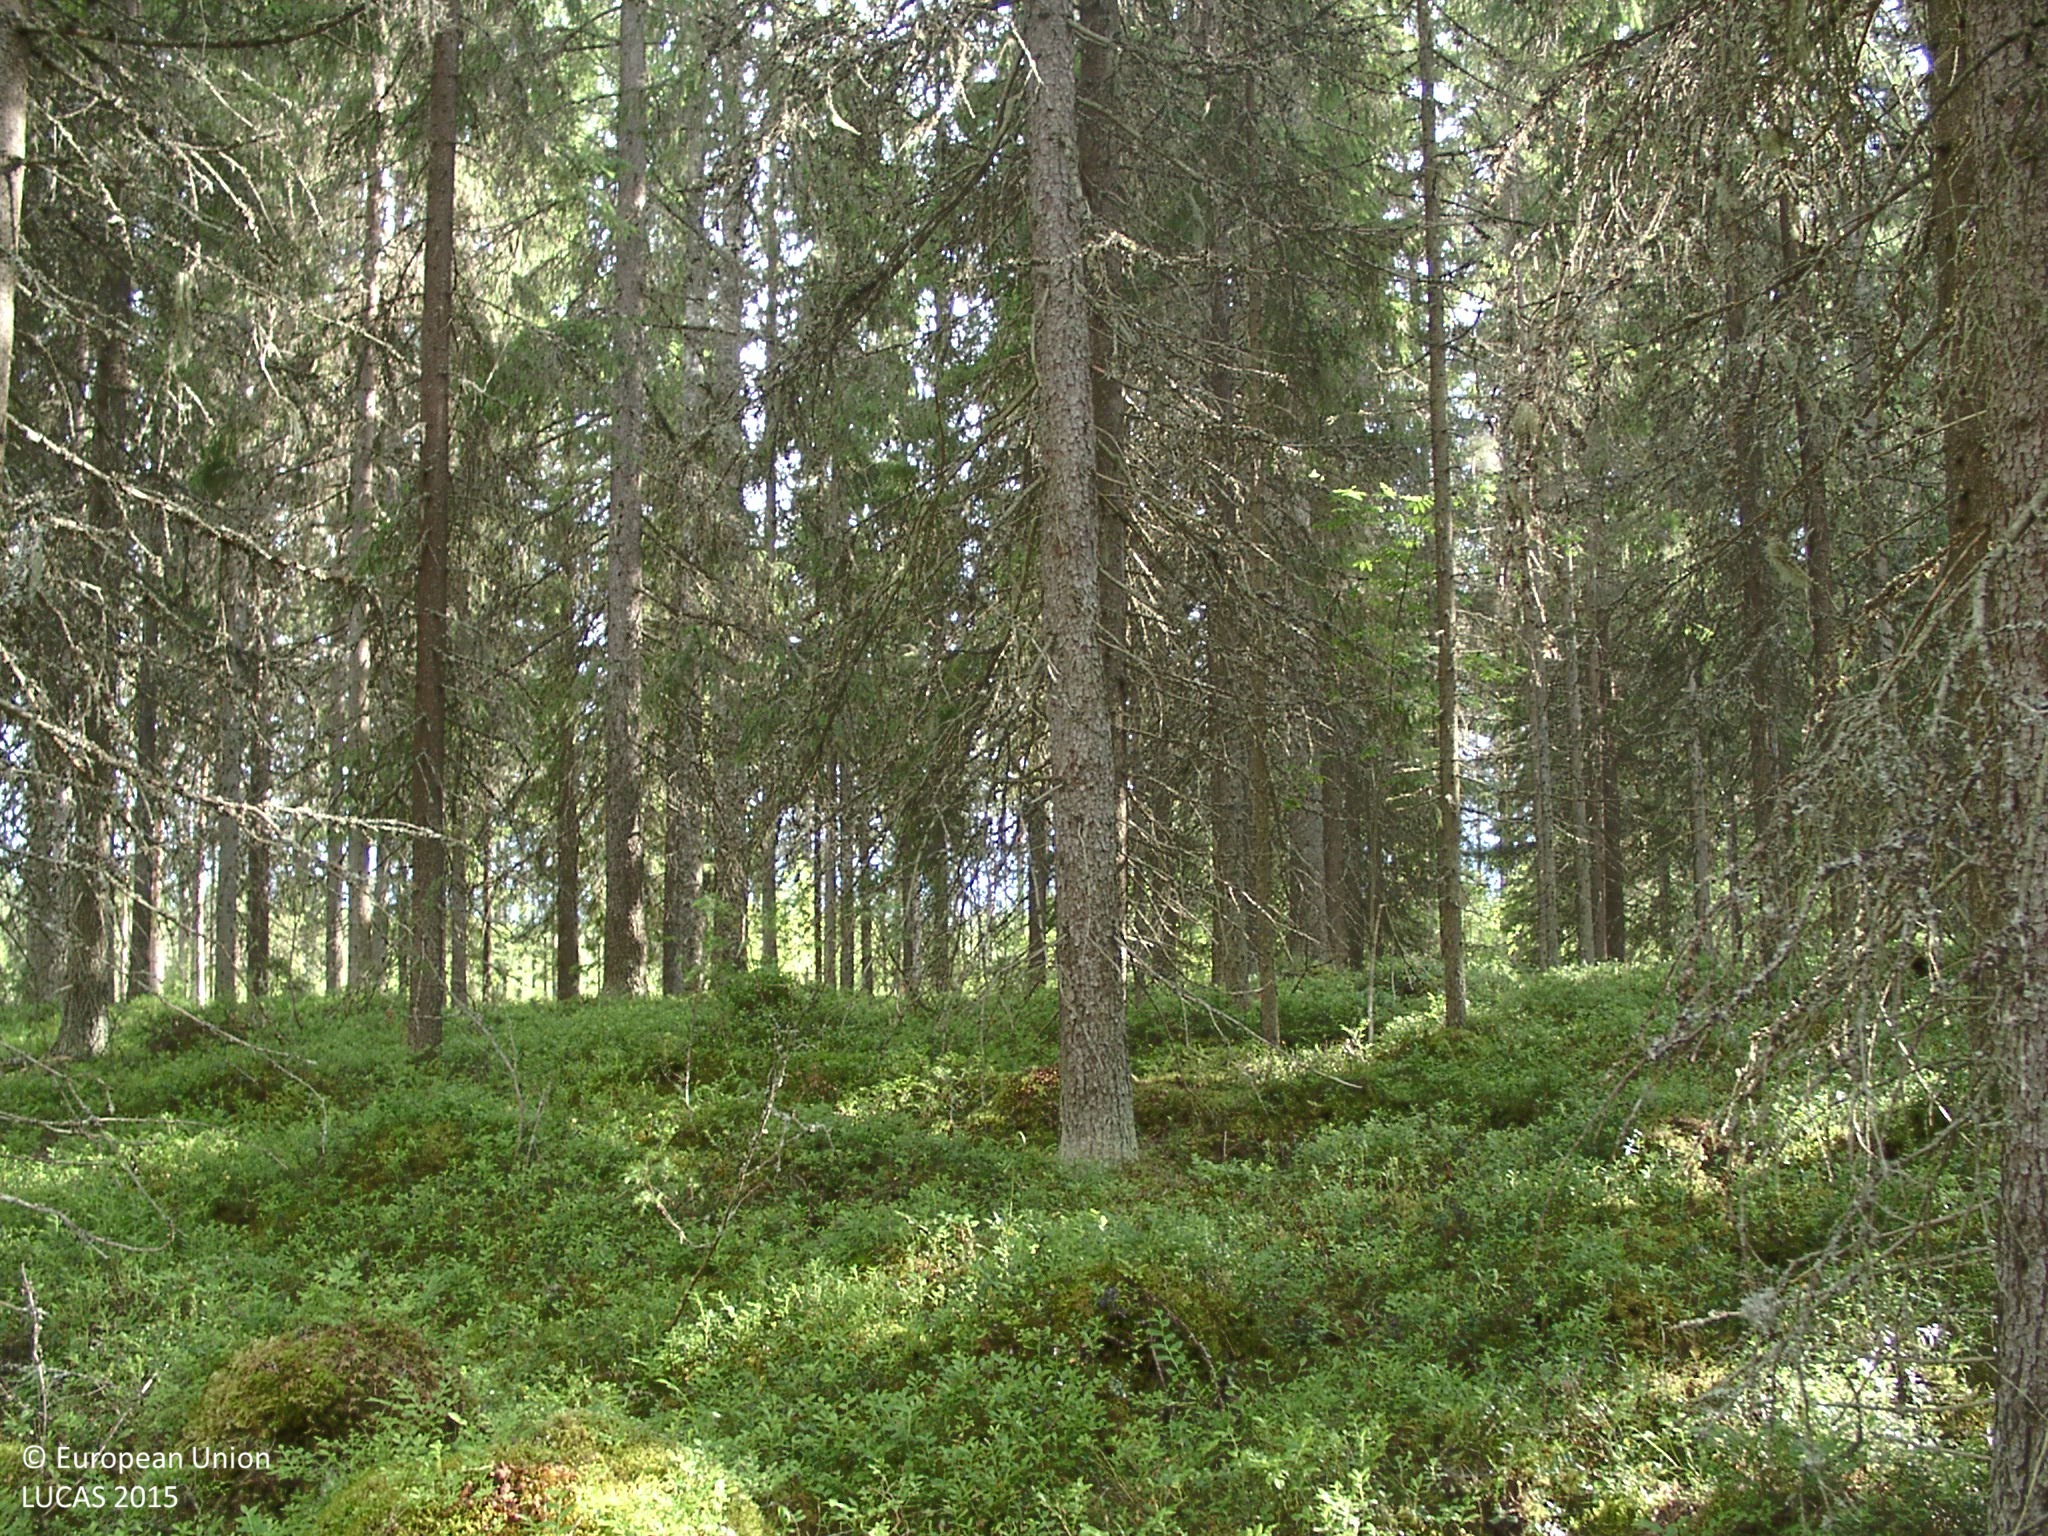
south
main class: Woodland
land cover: Other coniferous woodland
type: boreal forest
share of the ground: 50 - 75 %
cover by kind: coniferous forest trees 55 %, shrubs 25 %, broadleaved forest trees 15 %, lichens and mosses 5 %
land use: Forestry
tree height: > 5 m
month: July
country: FI
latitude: 62.2242
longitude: 25.1679
